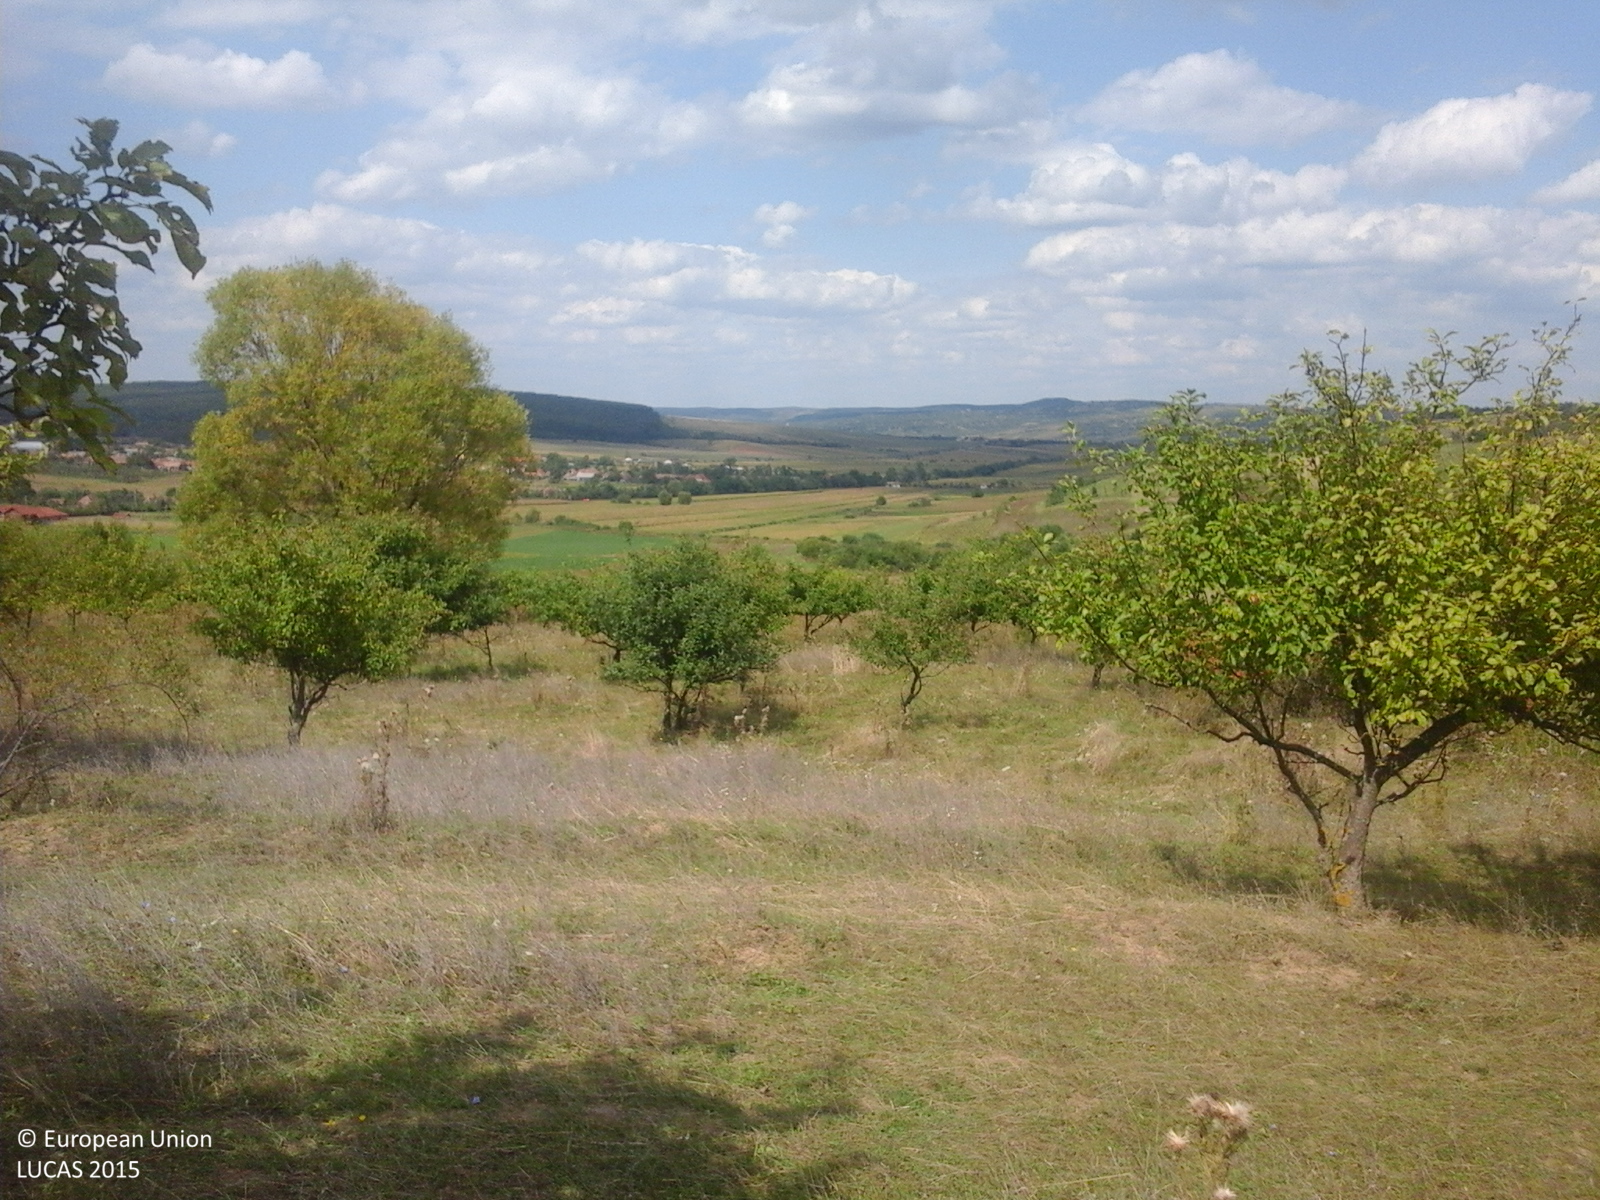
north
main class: Cropland
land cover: Apple fruit
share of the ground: > 75 %
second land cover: Grassland without tree/shrub cover
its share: > 75 %
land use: Agriculture (excluding fallow land and kitchen gardens)
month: September
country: RO
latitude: 47.2859
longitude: 22.8467
